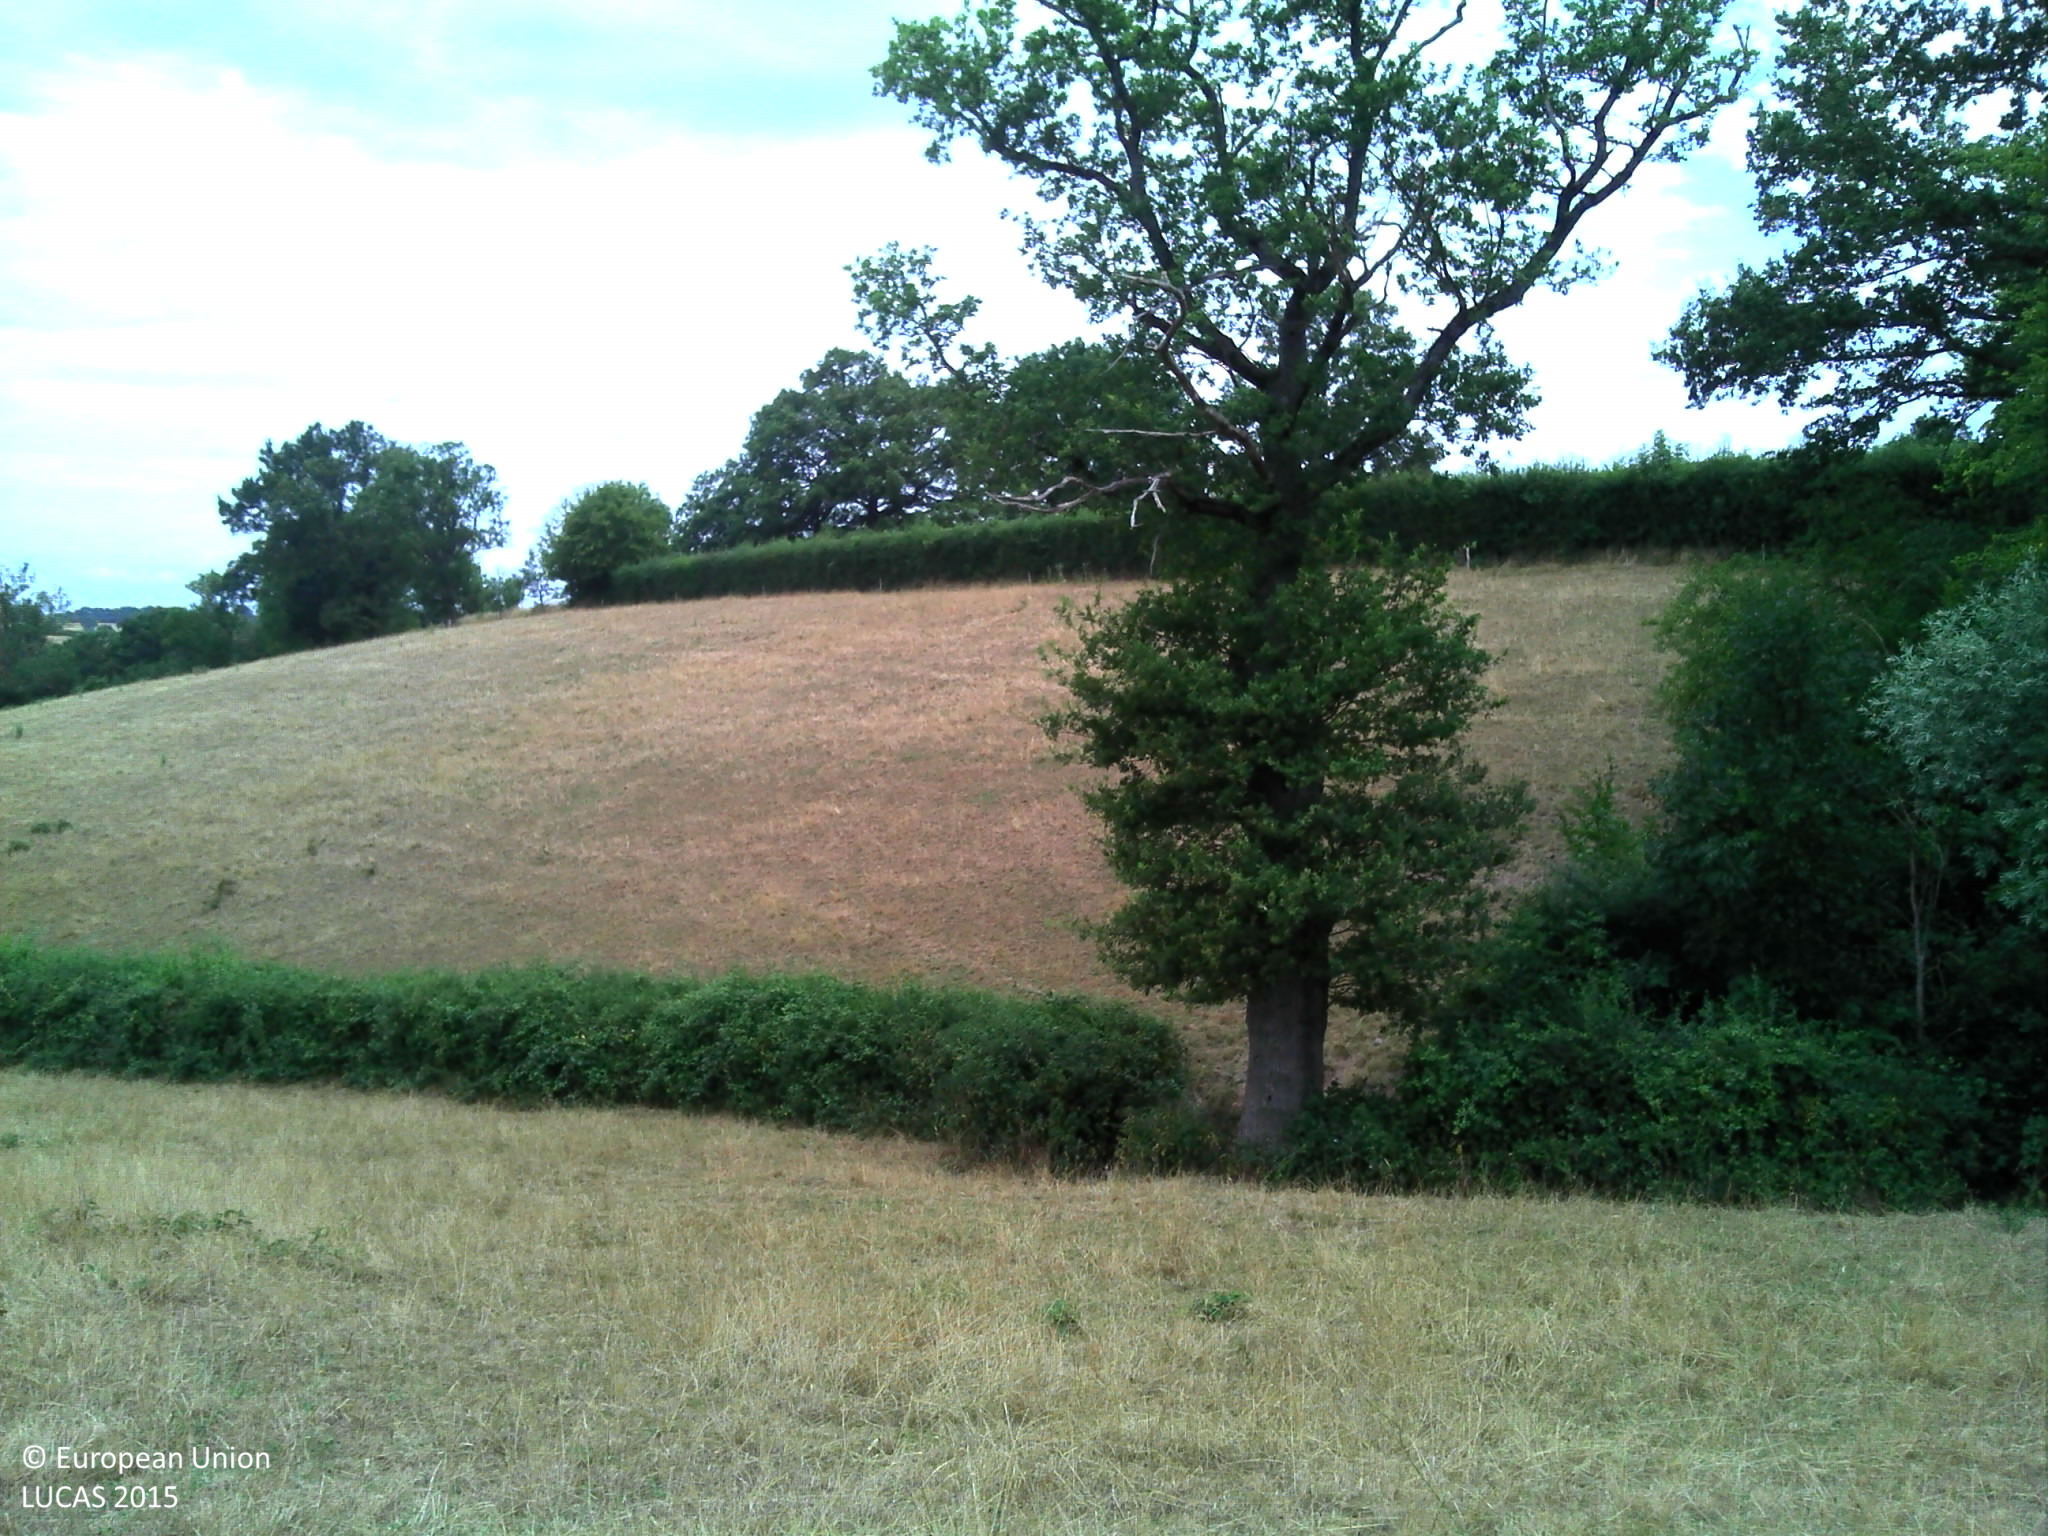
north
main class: Grassland
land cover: Grassland without tree/shrub cover
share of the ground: > 75 %
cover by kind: herbaceous plants 100 %
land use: Agriculture (excluding fallow land and kitchen gardens)
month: July
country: FR
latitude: 46.6268
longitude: 2.9831
